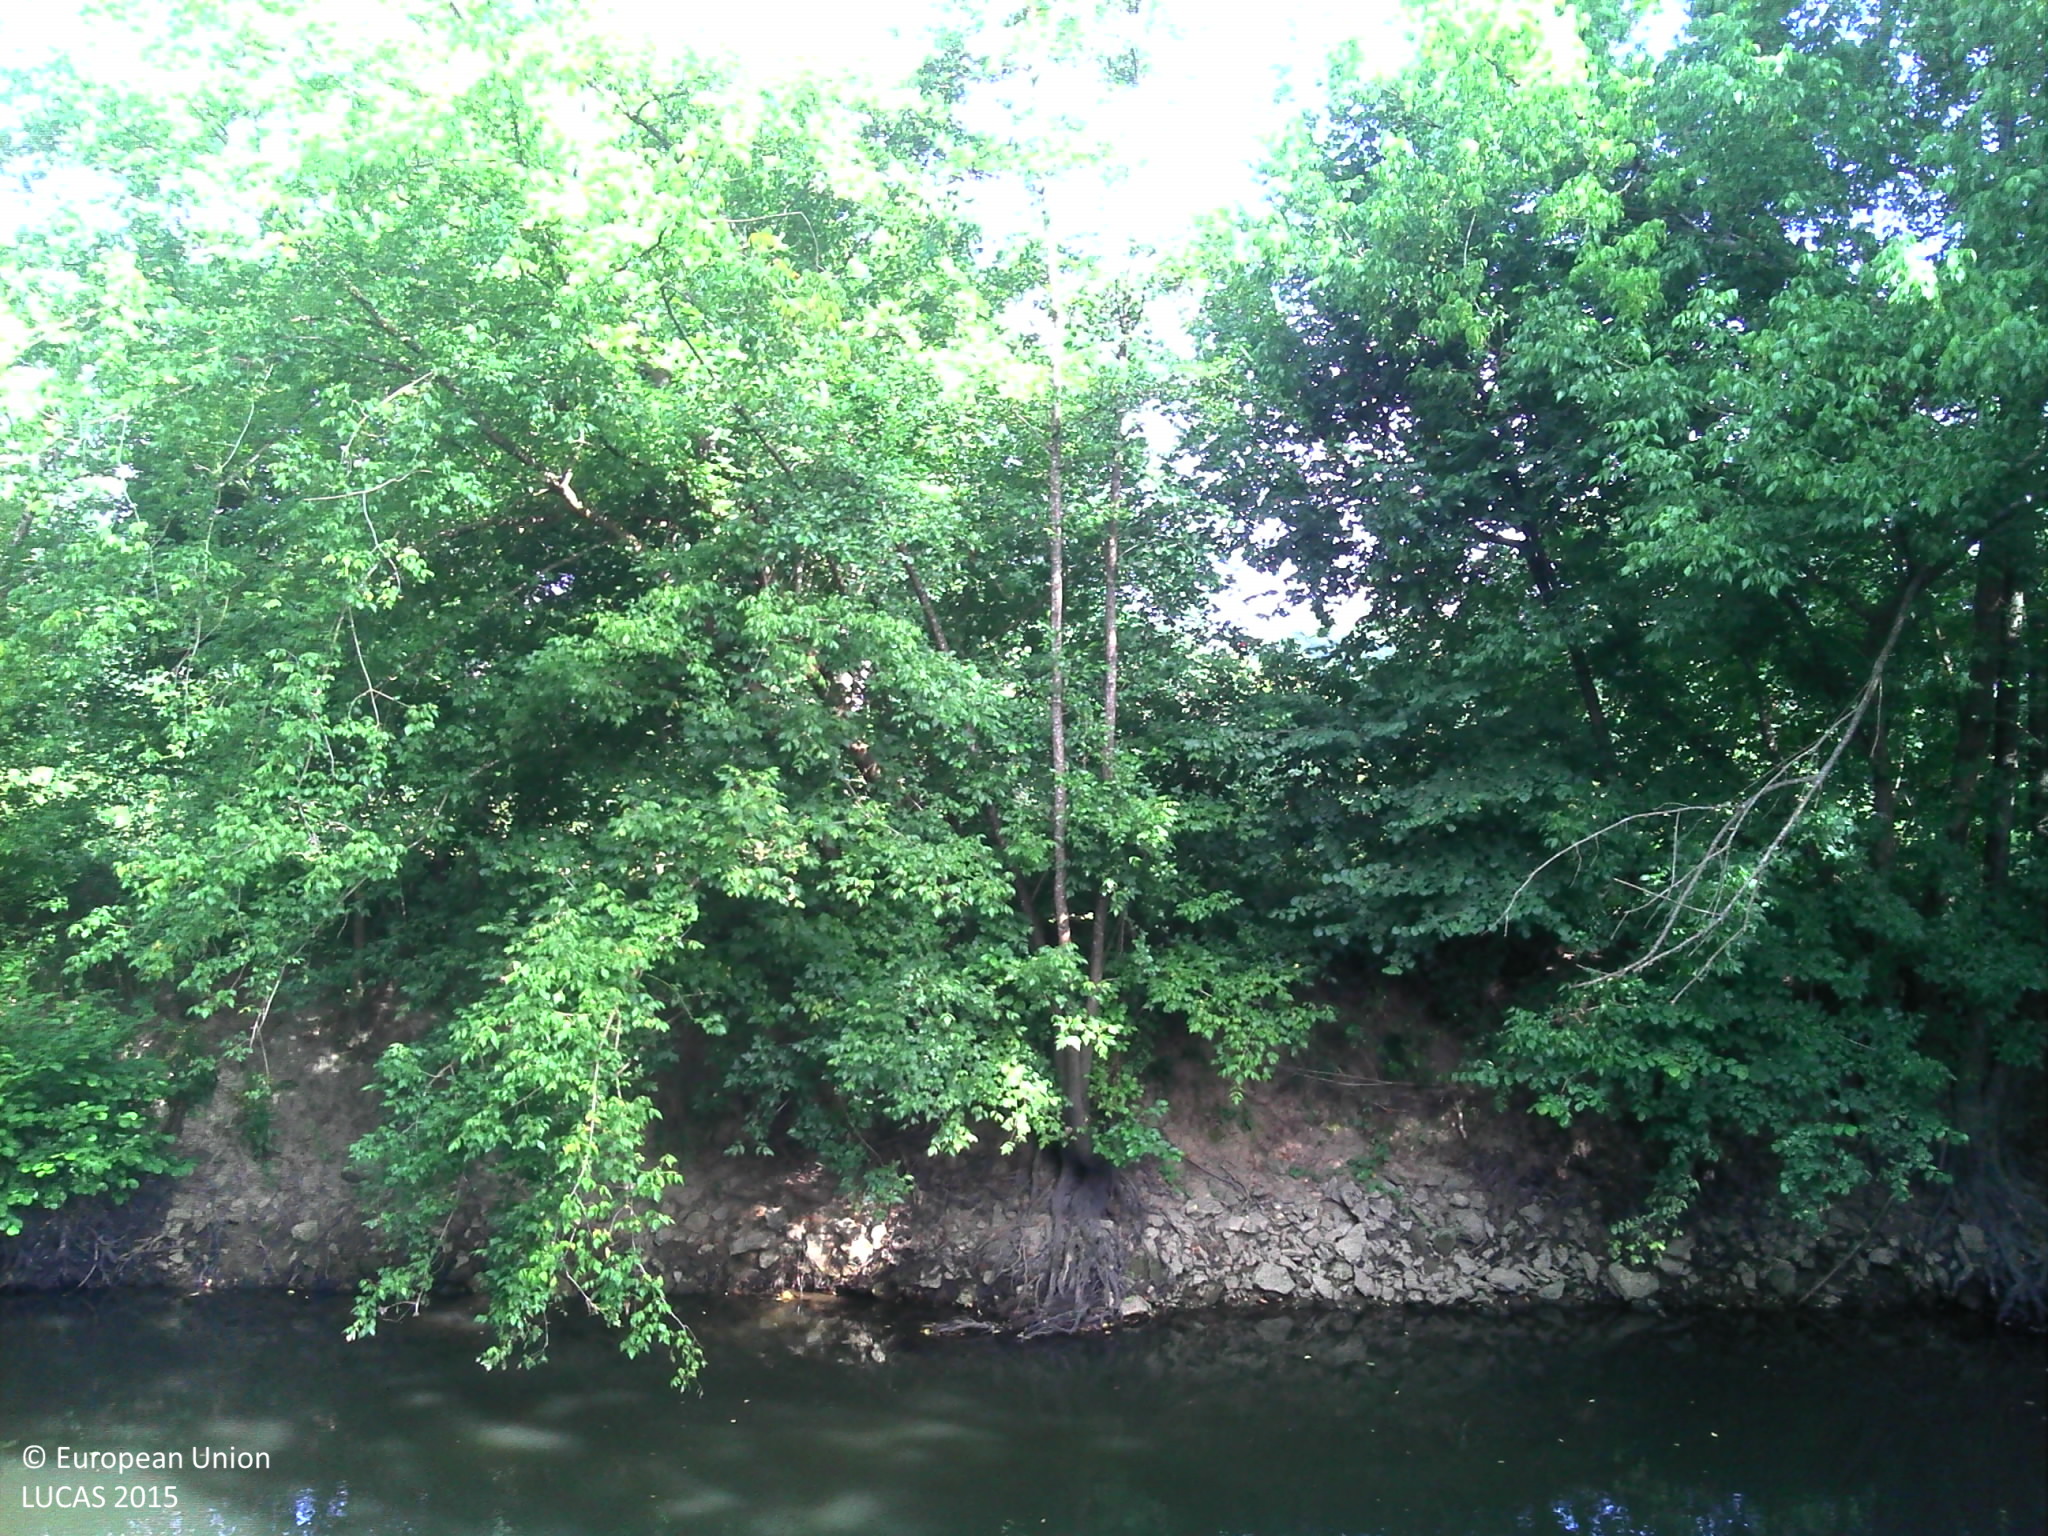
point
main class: Woodland
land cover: Broadleaved woodland
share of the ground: > 75 %
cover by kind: broadleaved forest trees 75 %, herbaceous plants 20 %, lichens and mosses 5 %
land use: Forestry
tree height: > 5 m
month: July
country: FR
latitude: 43.8605
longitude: -0.7762
